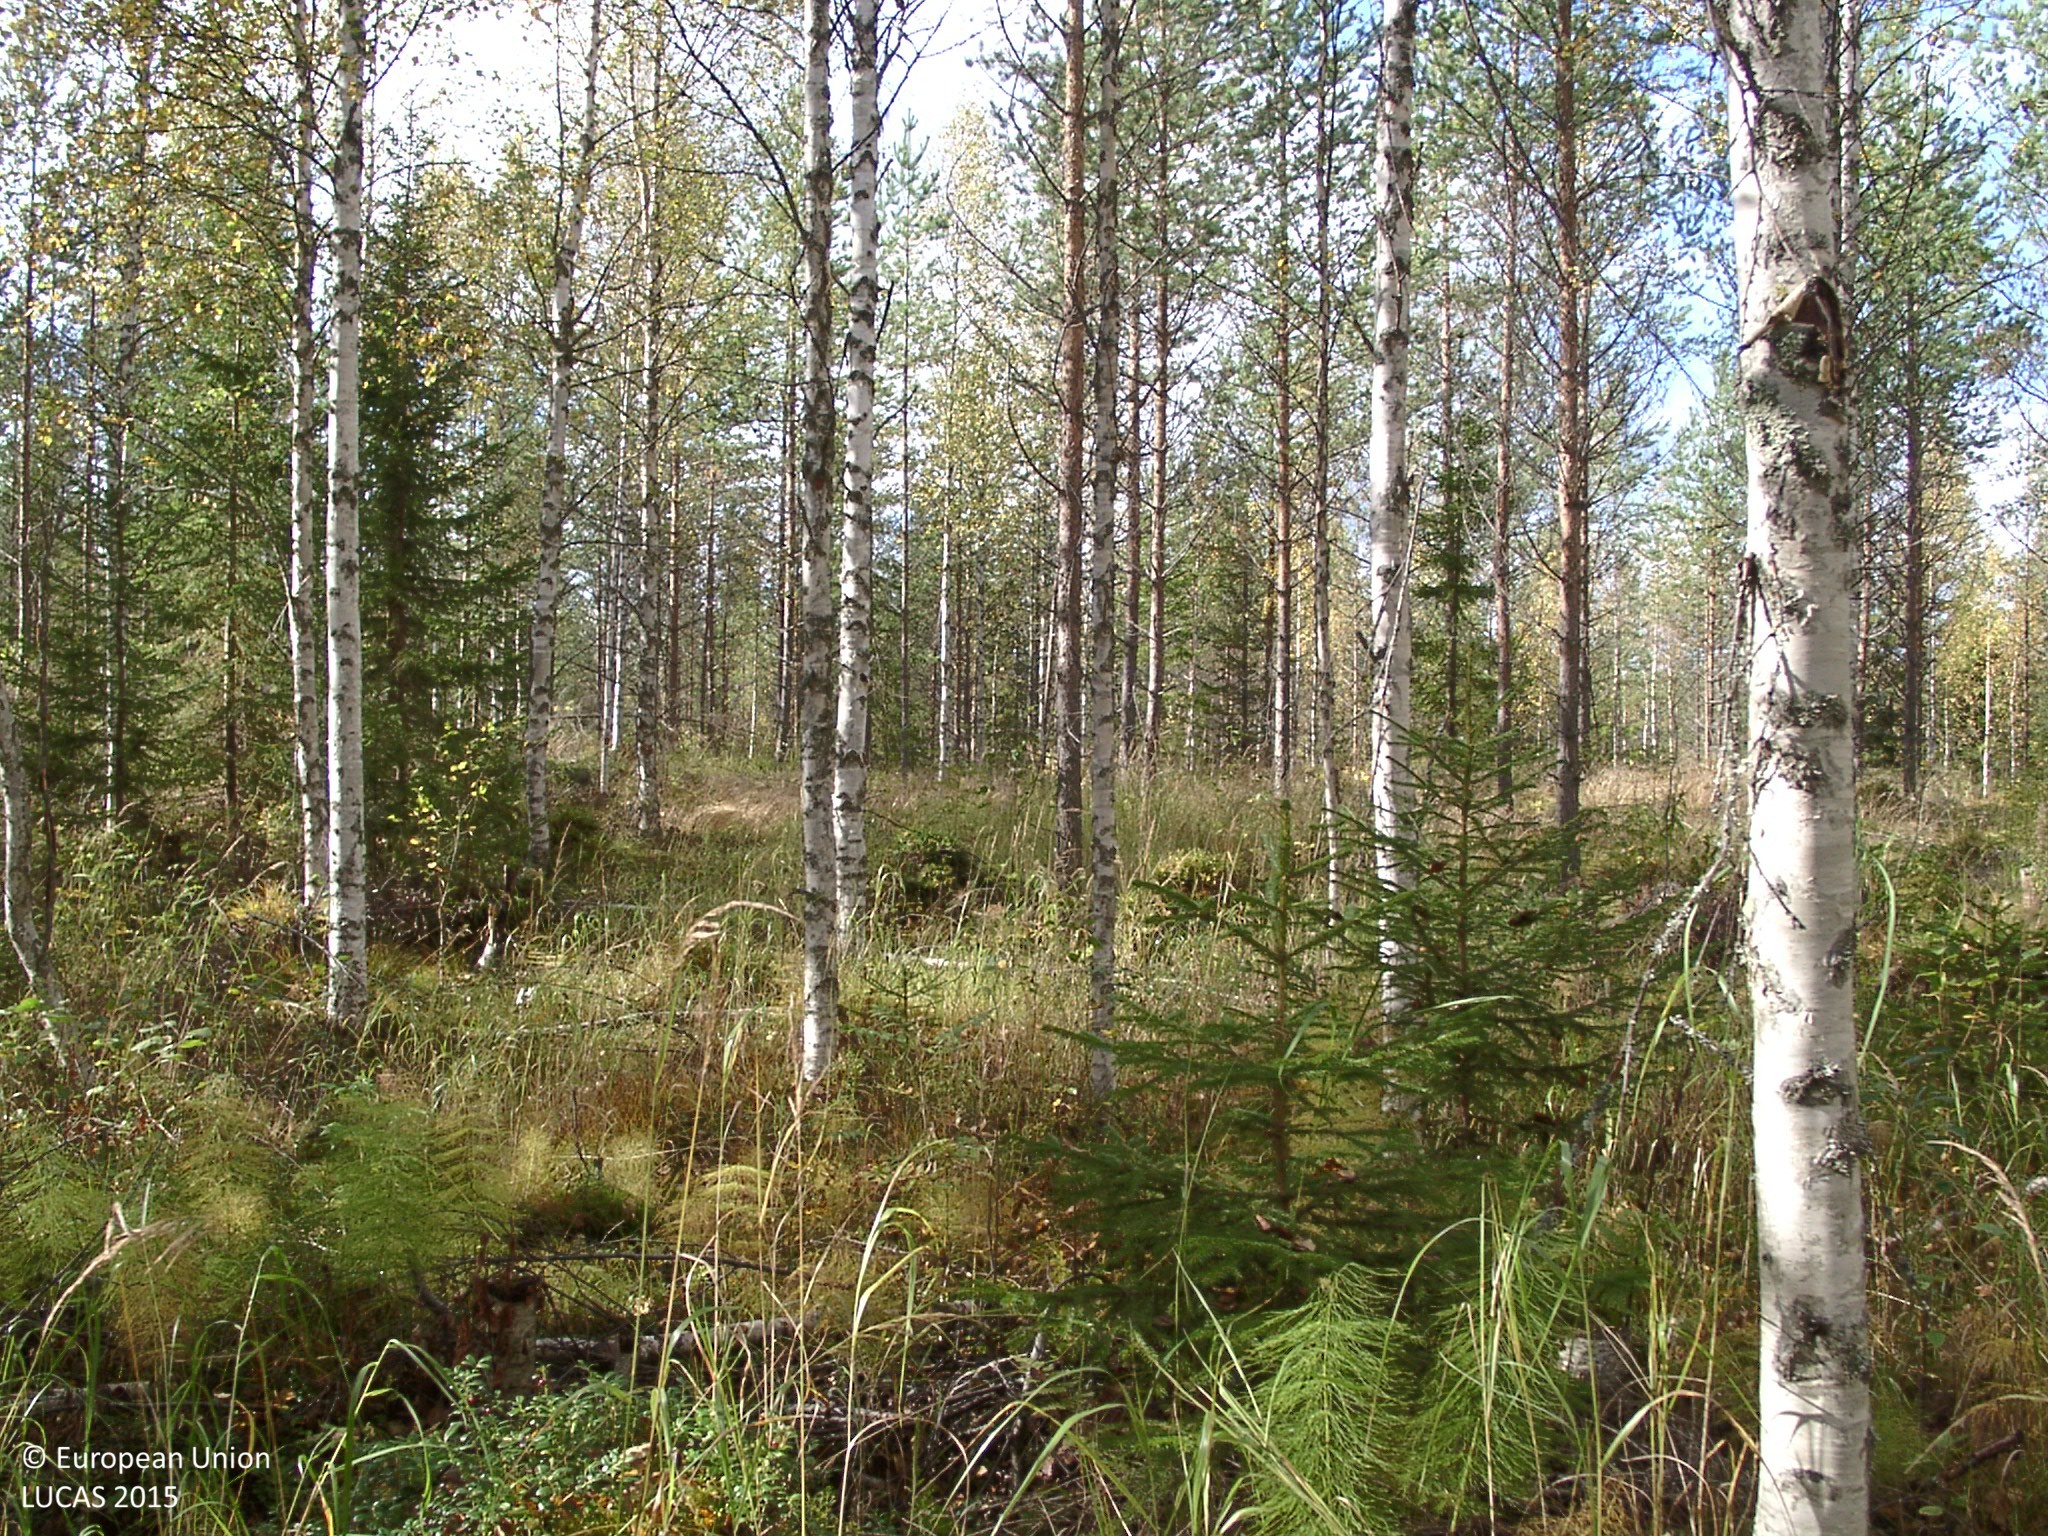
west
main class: Woodland
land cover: Pine dominated mixed woodland
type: boreal forest
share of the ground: 50 - 75 %
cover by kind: broadleaved forest trees 45 %, herbaceous plants 25 %, coniferous forest trees 15 %, lichens and mosses 10 %, shrubs 5 %
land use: Forestry
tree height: > 5 m
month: September
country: FI
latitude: 62.5182
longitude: 25.3564
